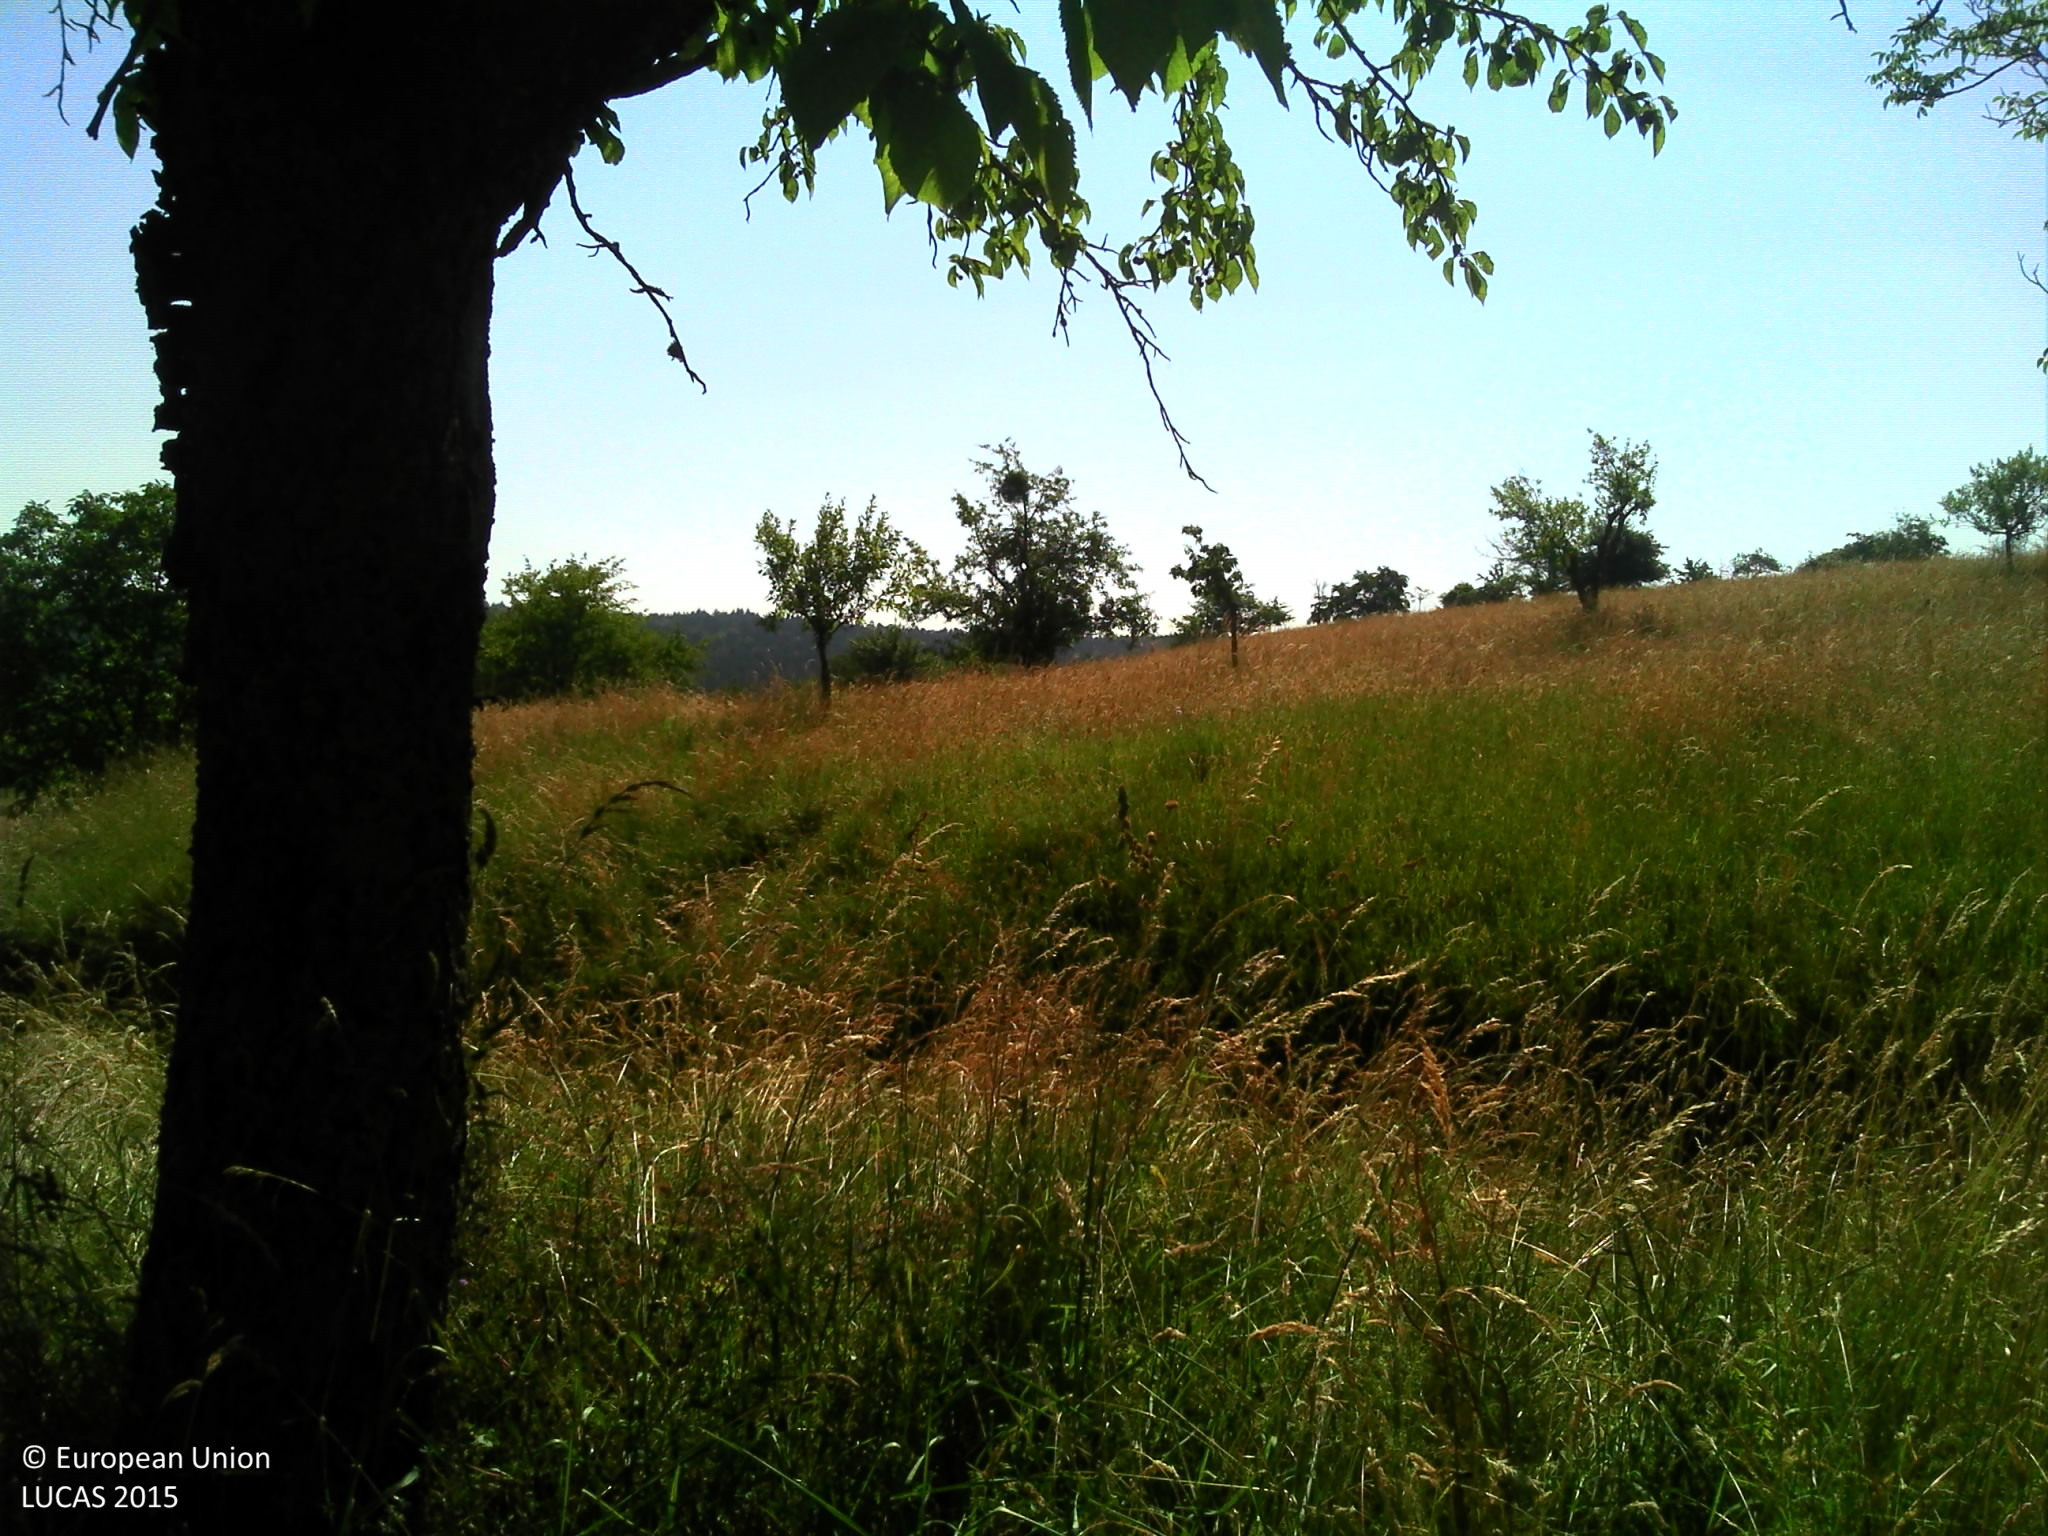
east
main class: Cropland
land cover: Cherry fruit
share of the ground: 50 - 75 %
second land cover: Apple fruit
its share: 10 - 25 %
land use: Agriculture (excluding fallow land and kitchen gardens)
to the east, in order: Cherry fruit; Apple fruit; Tracks; Grass margins; Grassland with sparse tree/shrub cover; Artificial constructions in urban areas; Grassland with sparse tree/shrub cover; Tracks; Grassland with sparse tree/shrub cover
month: June
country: FR
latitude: 48.6772
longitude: 7.3252
